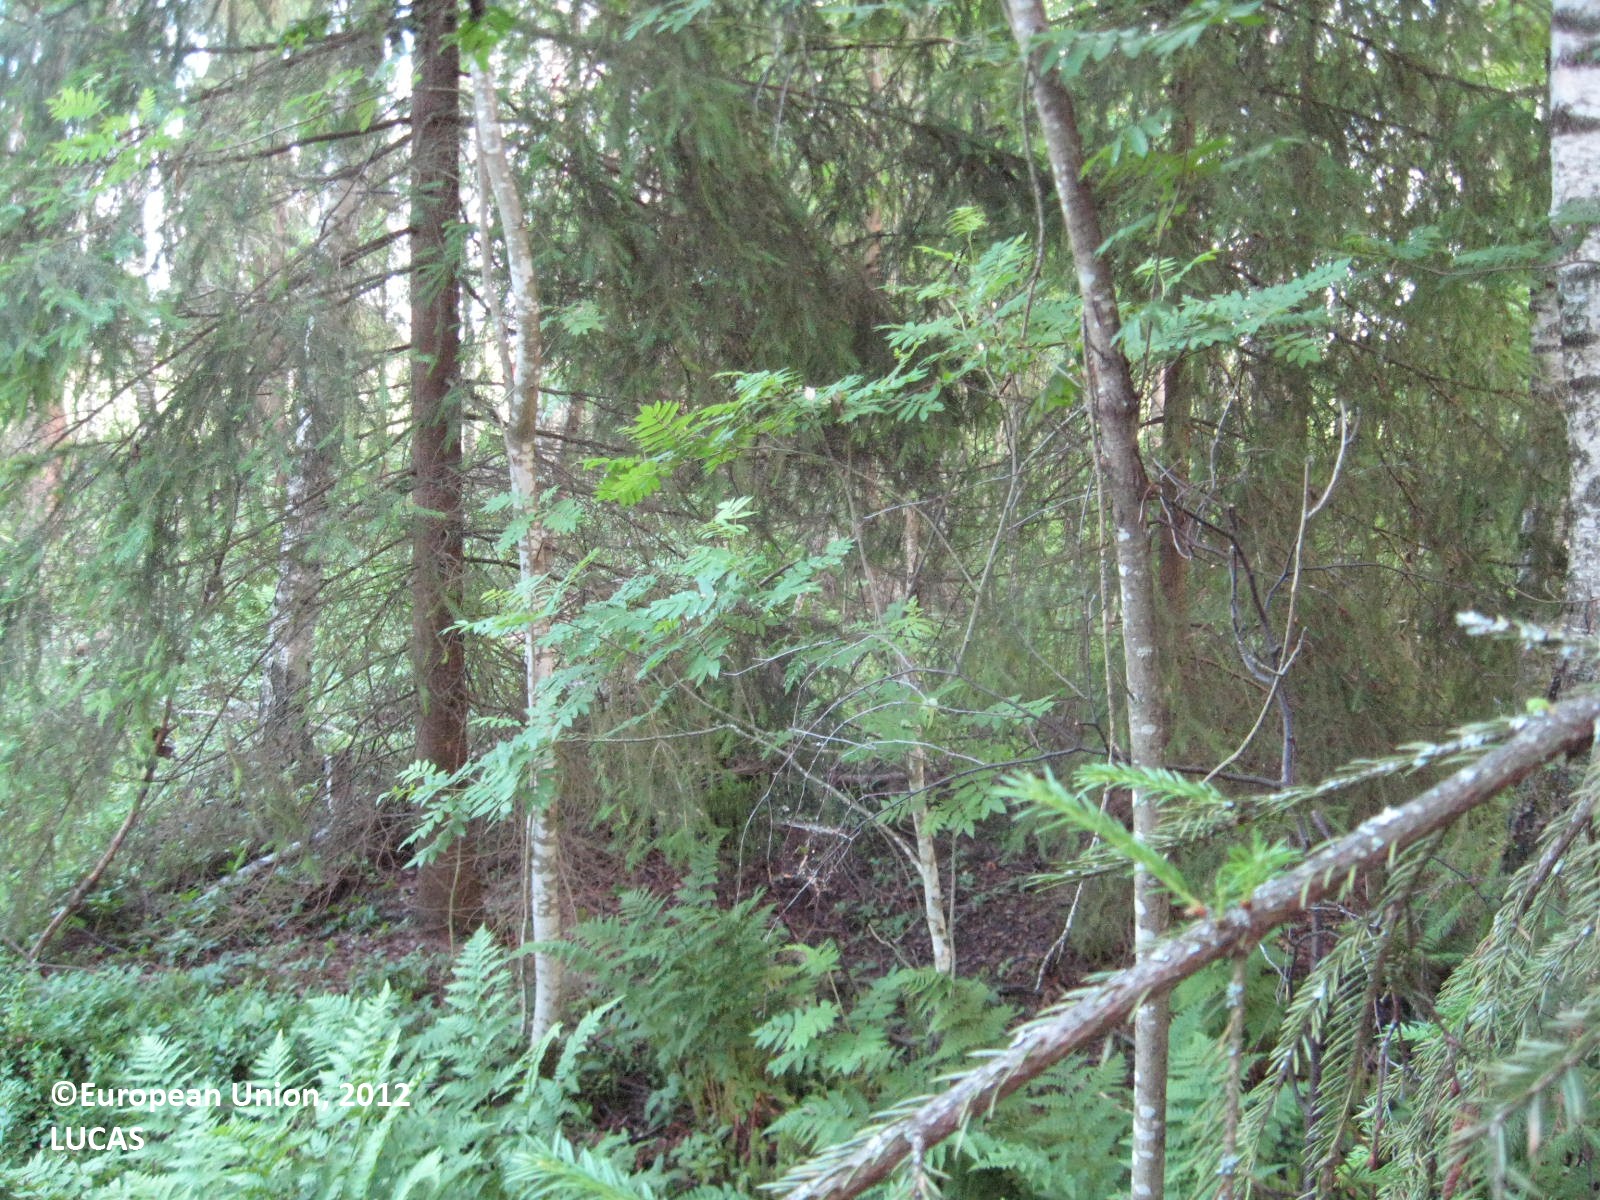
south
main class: Woodland
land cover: Other mixed woodland
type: boreal forest
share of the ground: > 75 %
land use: Forestry
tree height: > 5 m
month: June
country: FI
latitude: 62.9067
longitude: 22.7900
